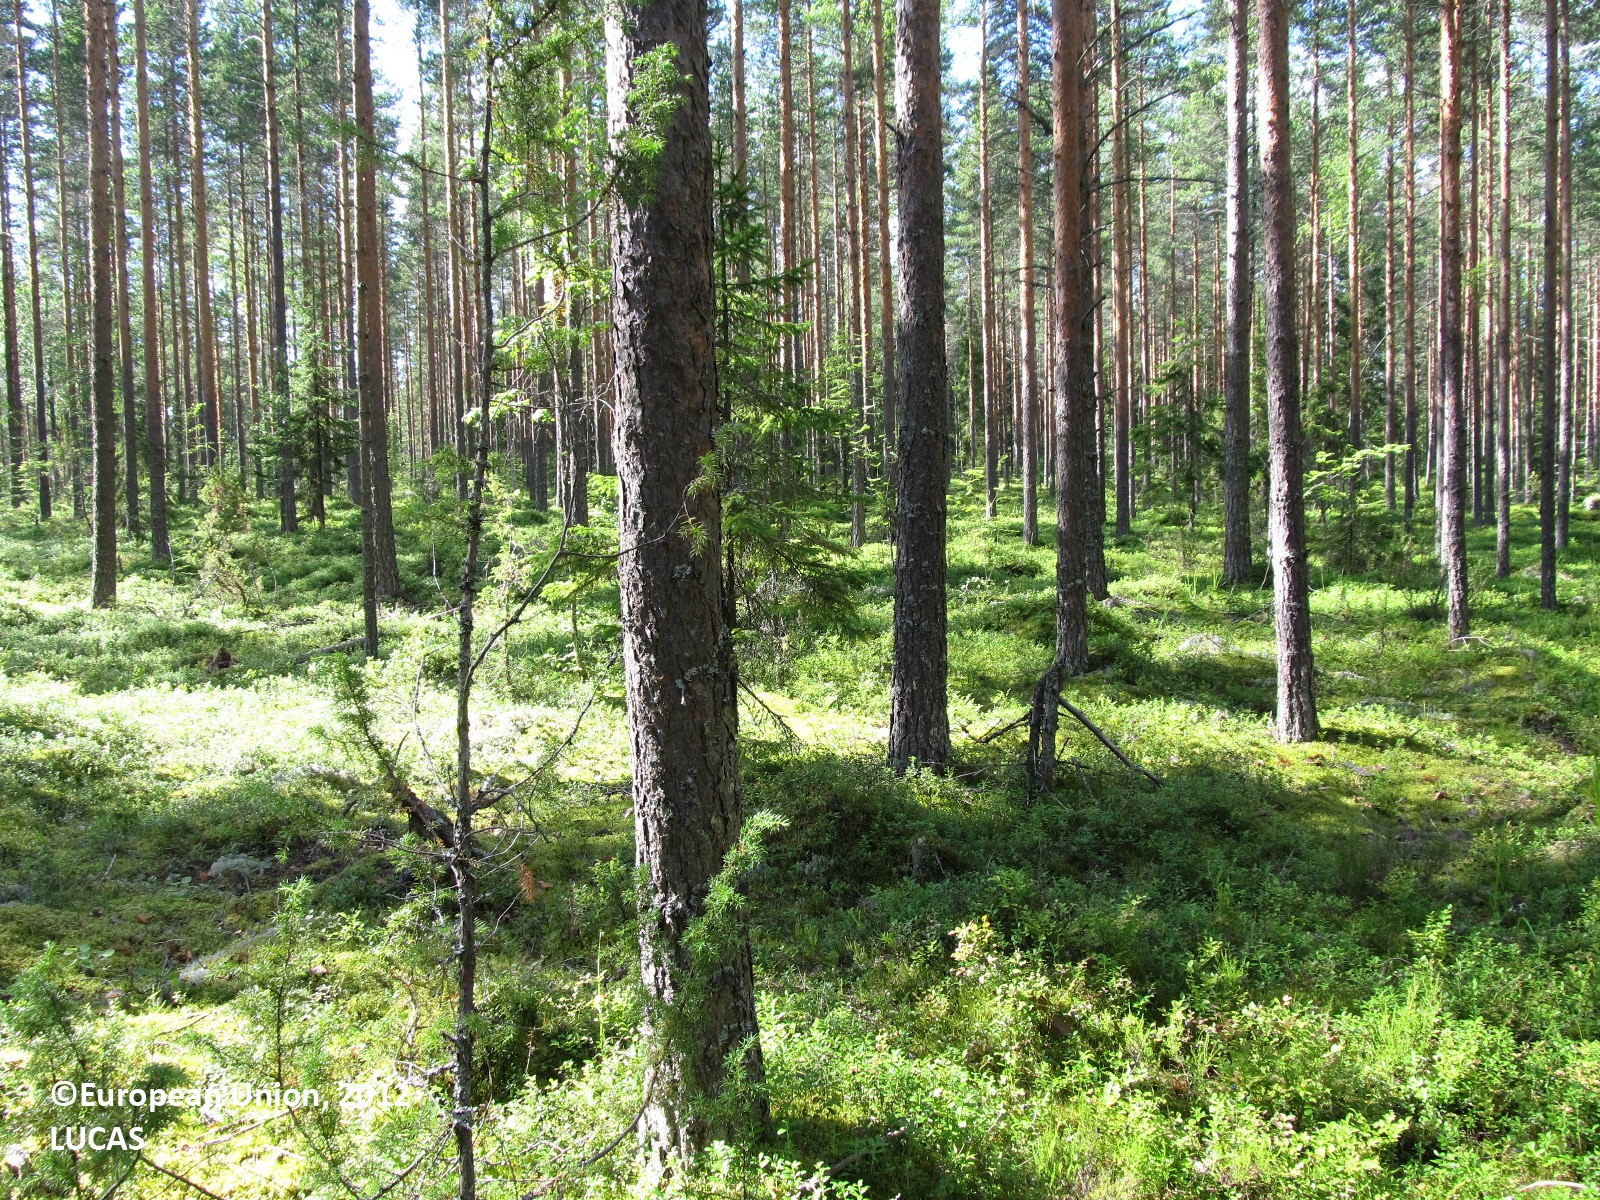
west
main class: Woodland
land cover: Pine dominated coniferous woodland
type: boreal forest
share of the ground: 50 - 75 %
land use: Forestry
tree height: > 5 m
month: July
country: FI
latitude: 61.8698
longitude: 27.9662
